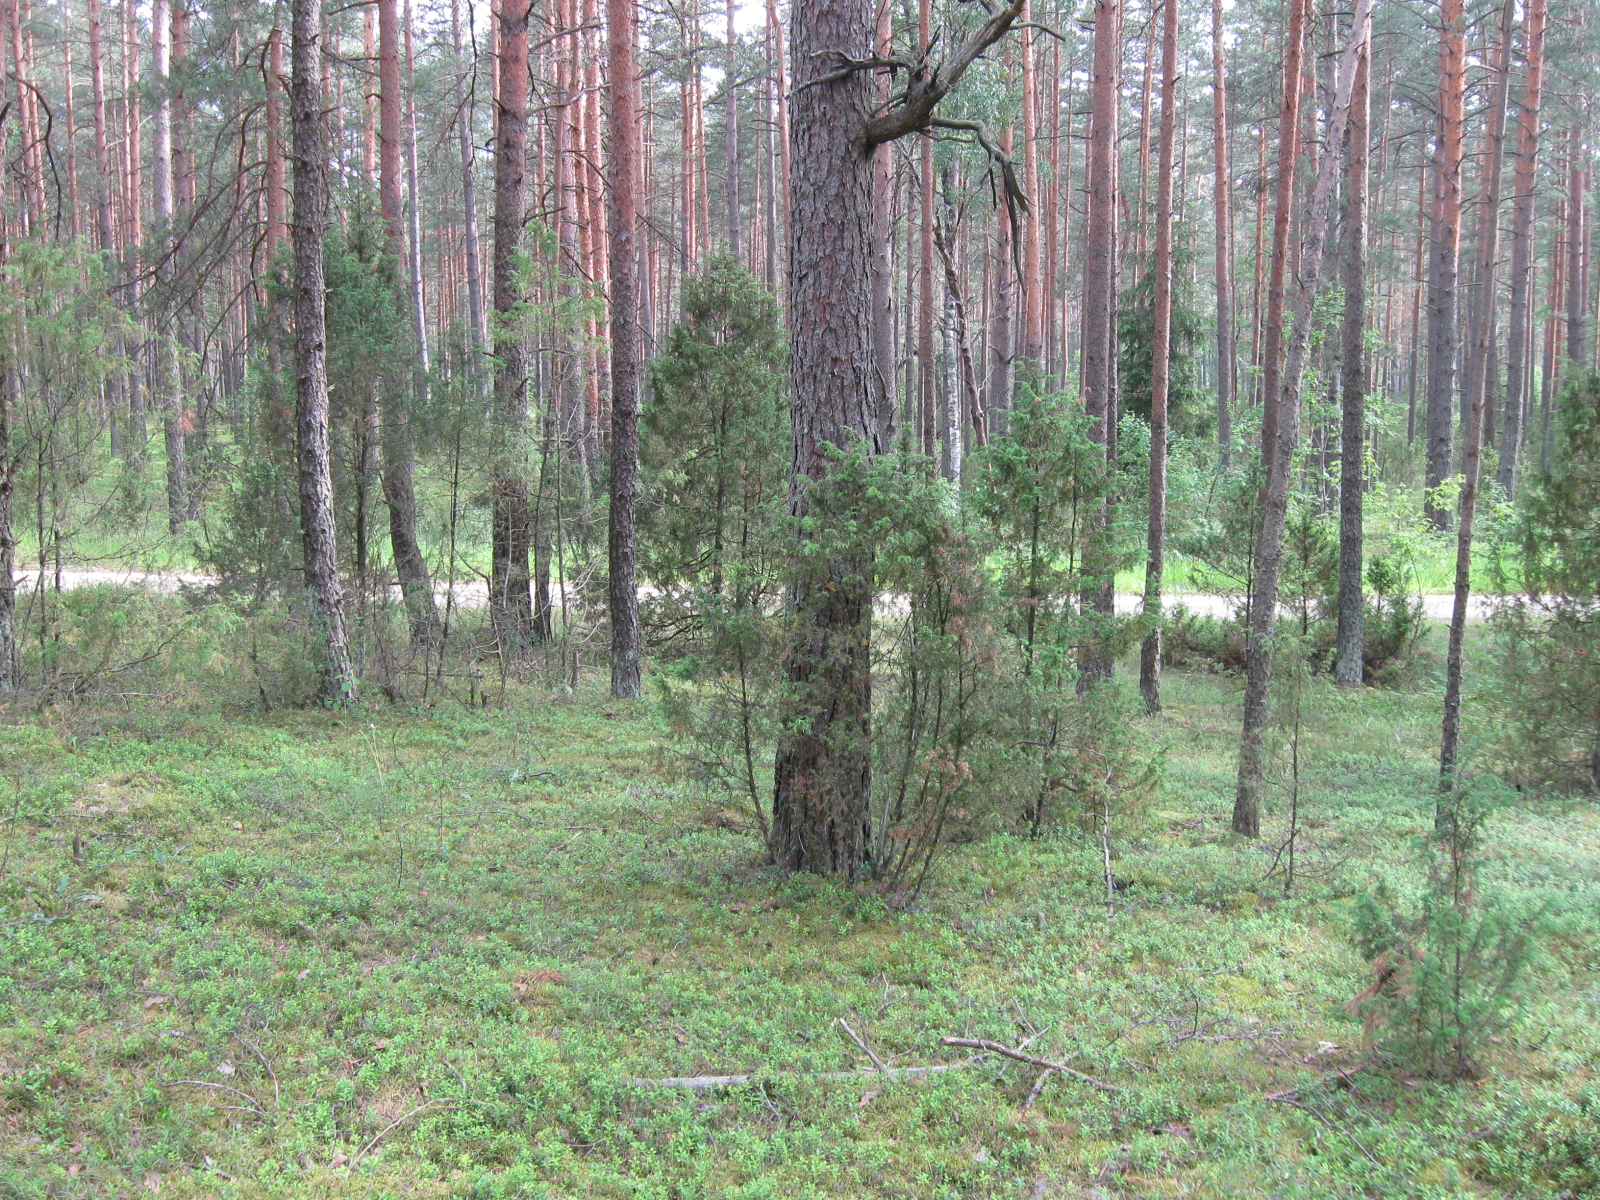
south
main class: Woodland
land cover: Pine dominated coniferous woodland
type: hemiboreal forest and nemoral coniferous forest and mixed broadleaved-coniferous forest
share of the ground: > 75 %
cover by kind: coniferous forest trees 80 %, lichens and mosses 15 %, herbaceous plants 5 %
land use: Forestry
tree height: > 5 m
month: June
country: LT
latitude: 54.2084
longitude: 24.6263
